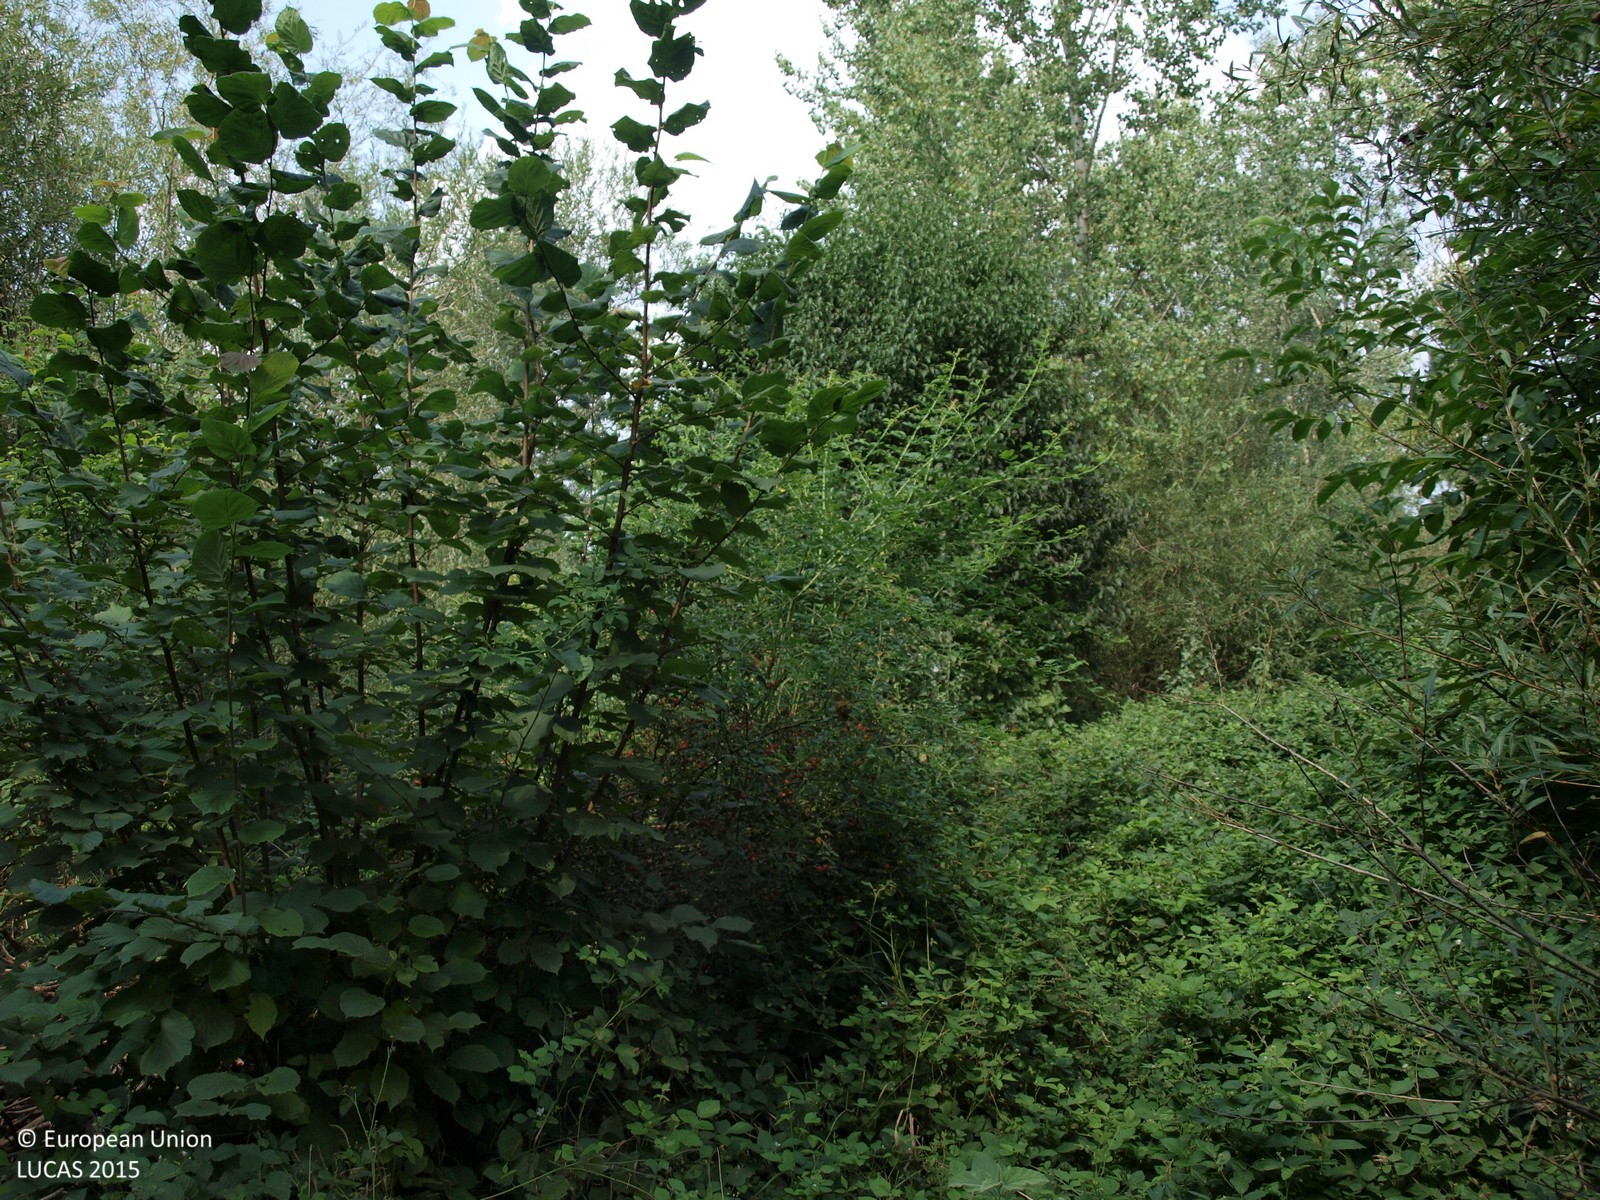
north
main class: Shrubland
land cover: Shrubland with sparse tree cover
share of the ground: > 75 %
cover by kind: shrubs 95 %, broadleaved forest trees 5 %
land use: Semi-natural and natural areas not in use
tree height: > 5 m
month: August
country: HR
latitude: 45.6806
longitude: 16.2506
